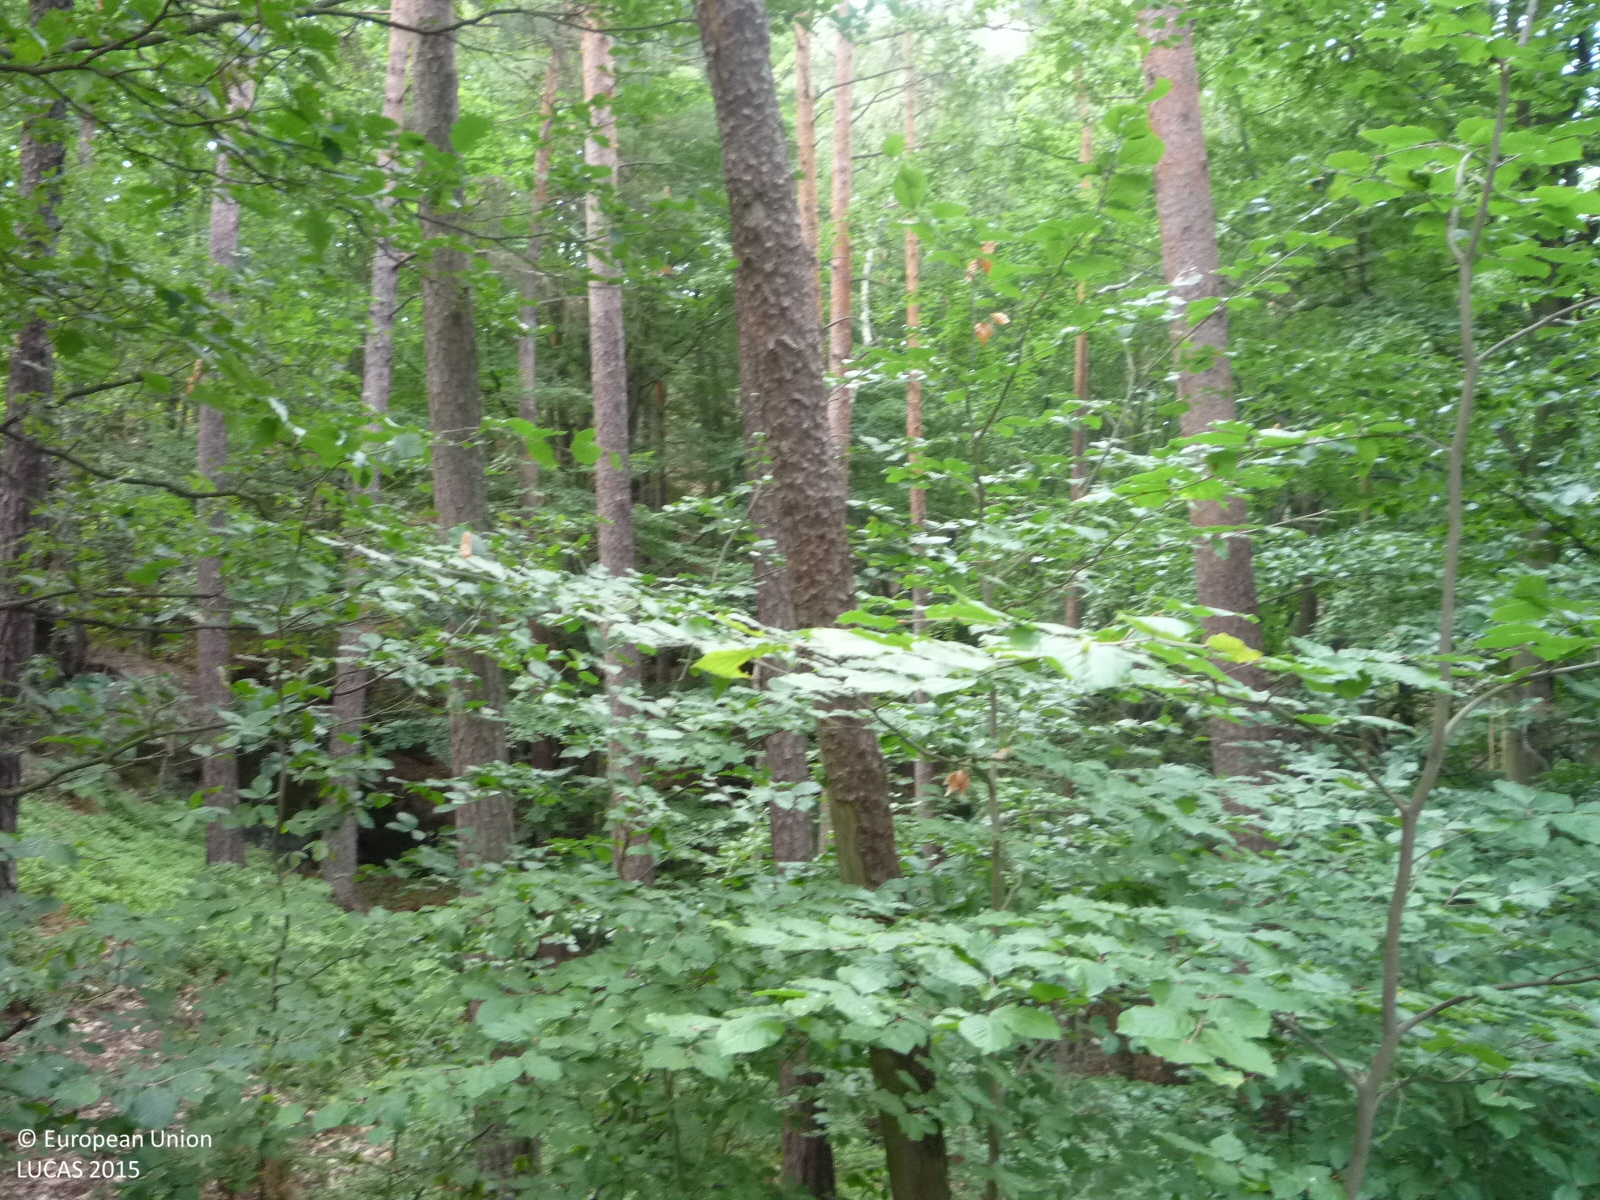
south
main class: Woodland
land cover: Pine dominated mixed woodland
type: hemiboreal forest and nemoral coniferous forest and mixed broadleaved-coniferous forest
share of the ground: > 75 %
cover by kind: coniferous forest trees 60 %, broadleaved forest trees 35 %, herbaceous plants 5 %
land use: Forestry
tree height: > 5 m
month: July
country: CZ
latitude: 50.5086
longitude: 14.5282
